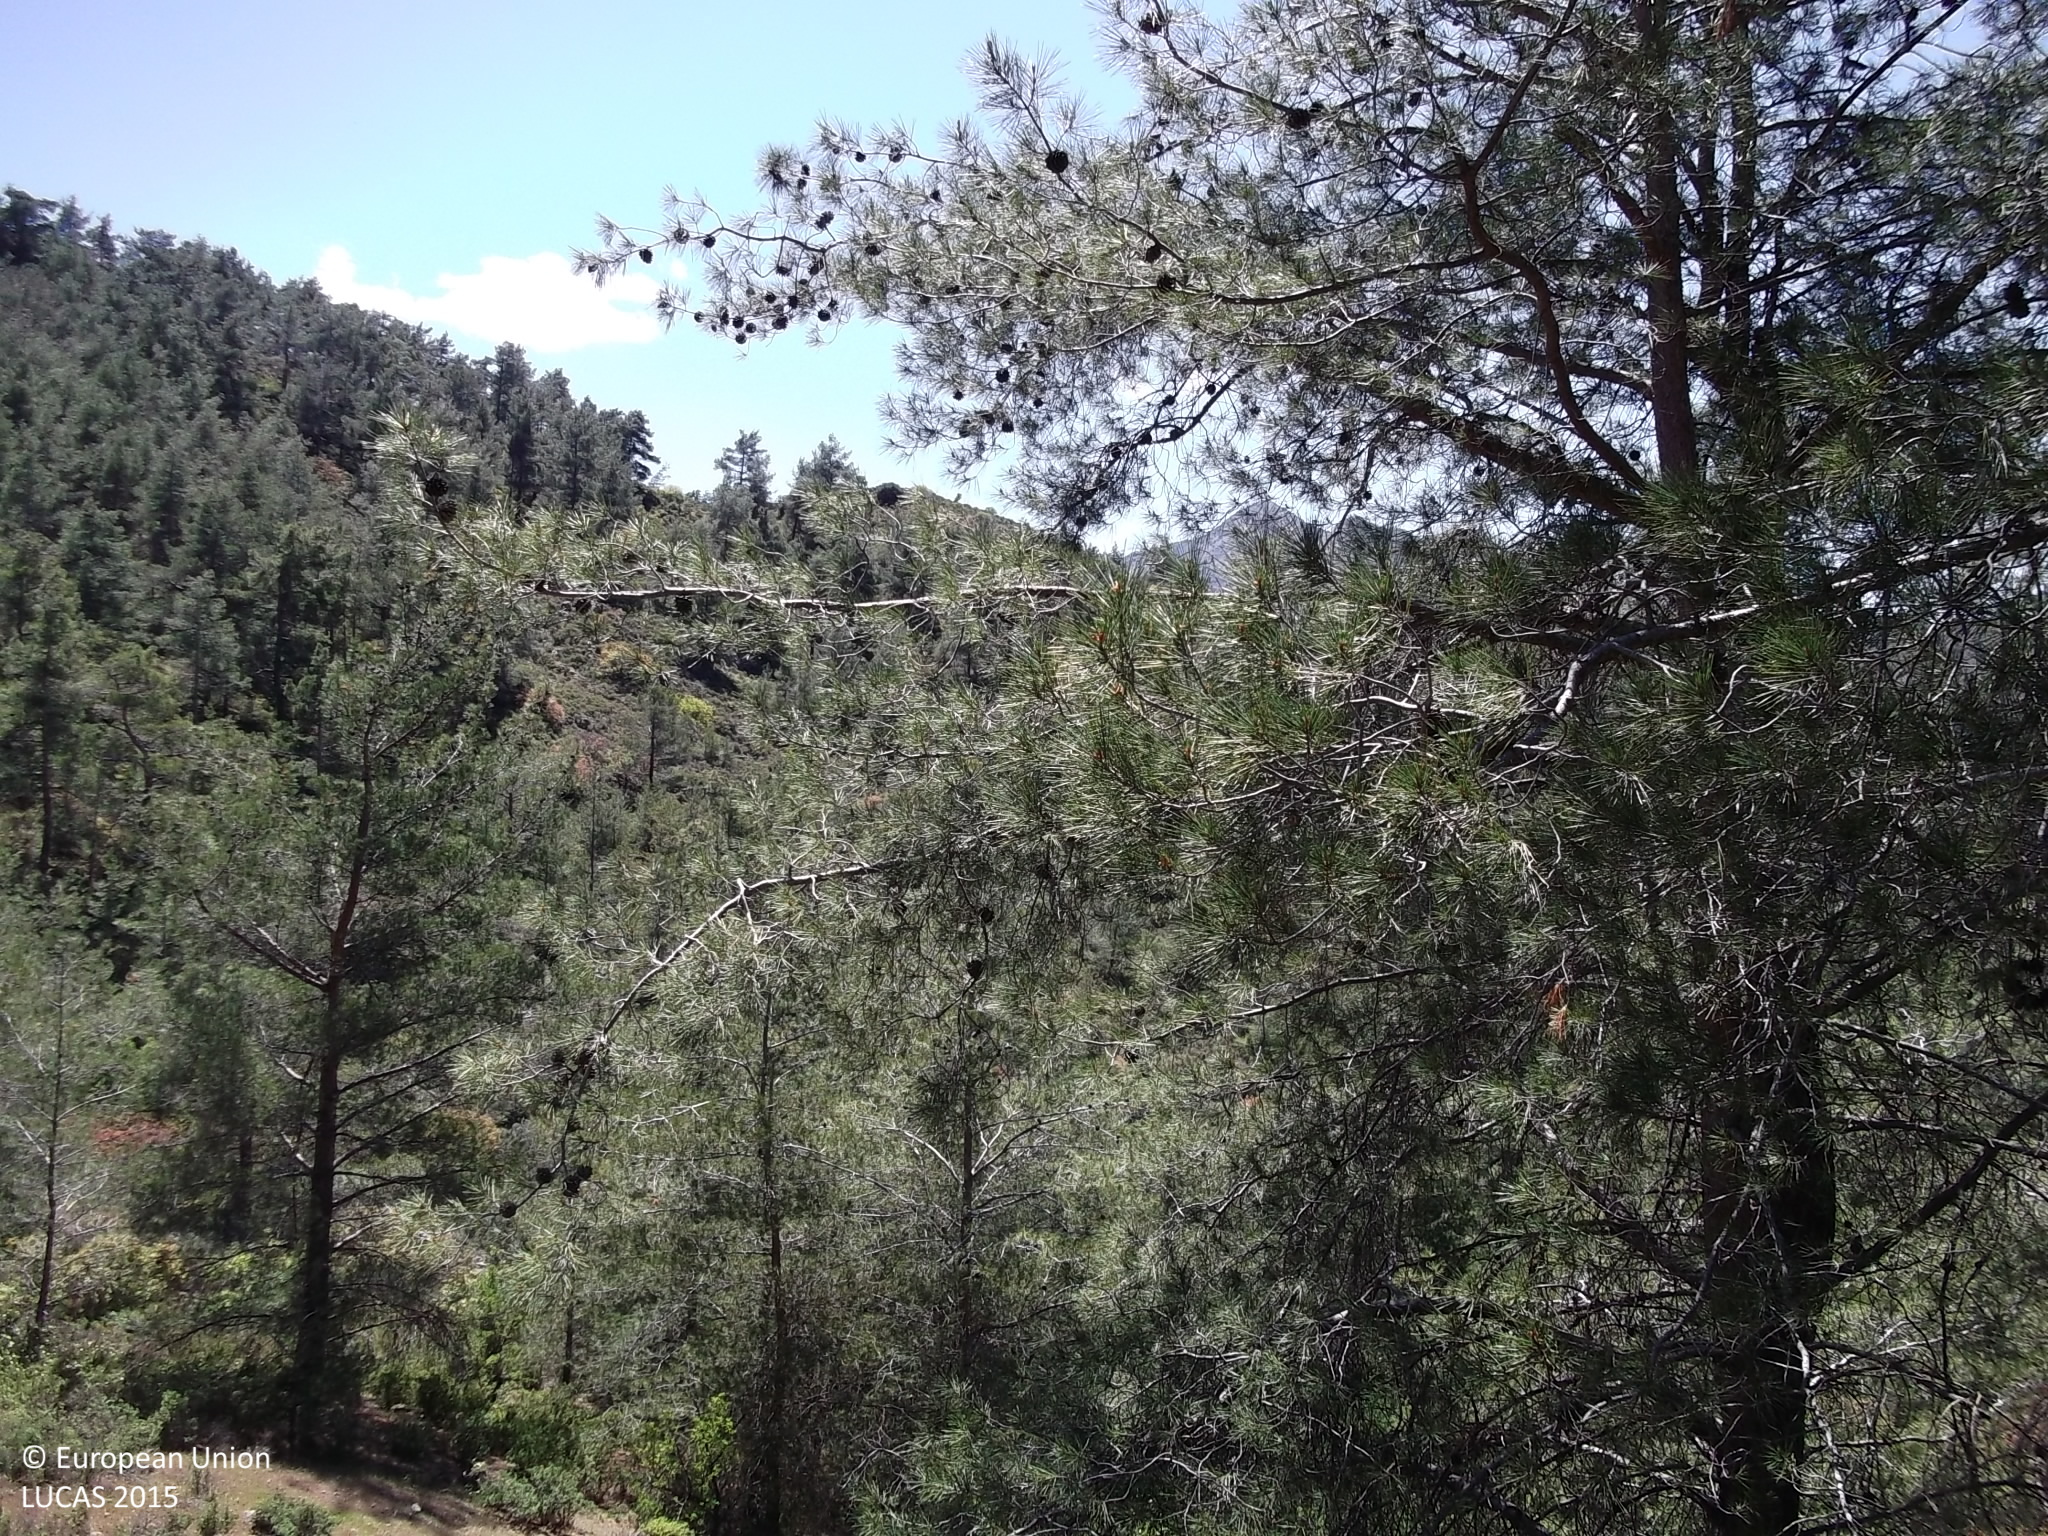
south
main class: Woodland
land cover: Pine dominated coniferous woodland
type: coniferous forest of the mediterranean region
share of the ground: 50 - 75 %
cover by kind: coniferous forest trees 70 %, shrubs 20 %, unconsolidated bare surface 10 %
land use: Semi-natural and natural areas not in use
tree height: > 5 m
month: April
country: CY
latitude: 34.9406
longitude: 33.1598
